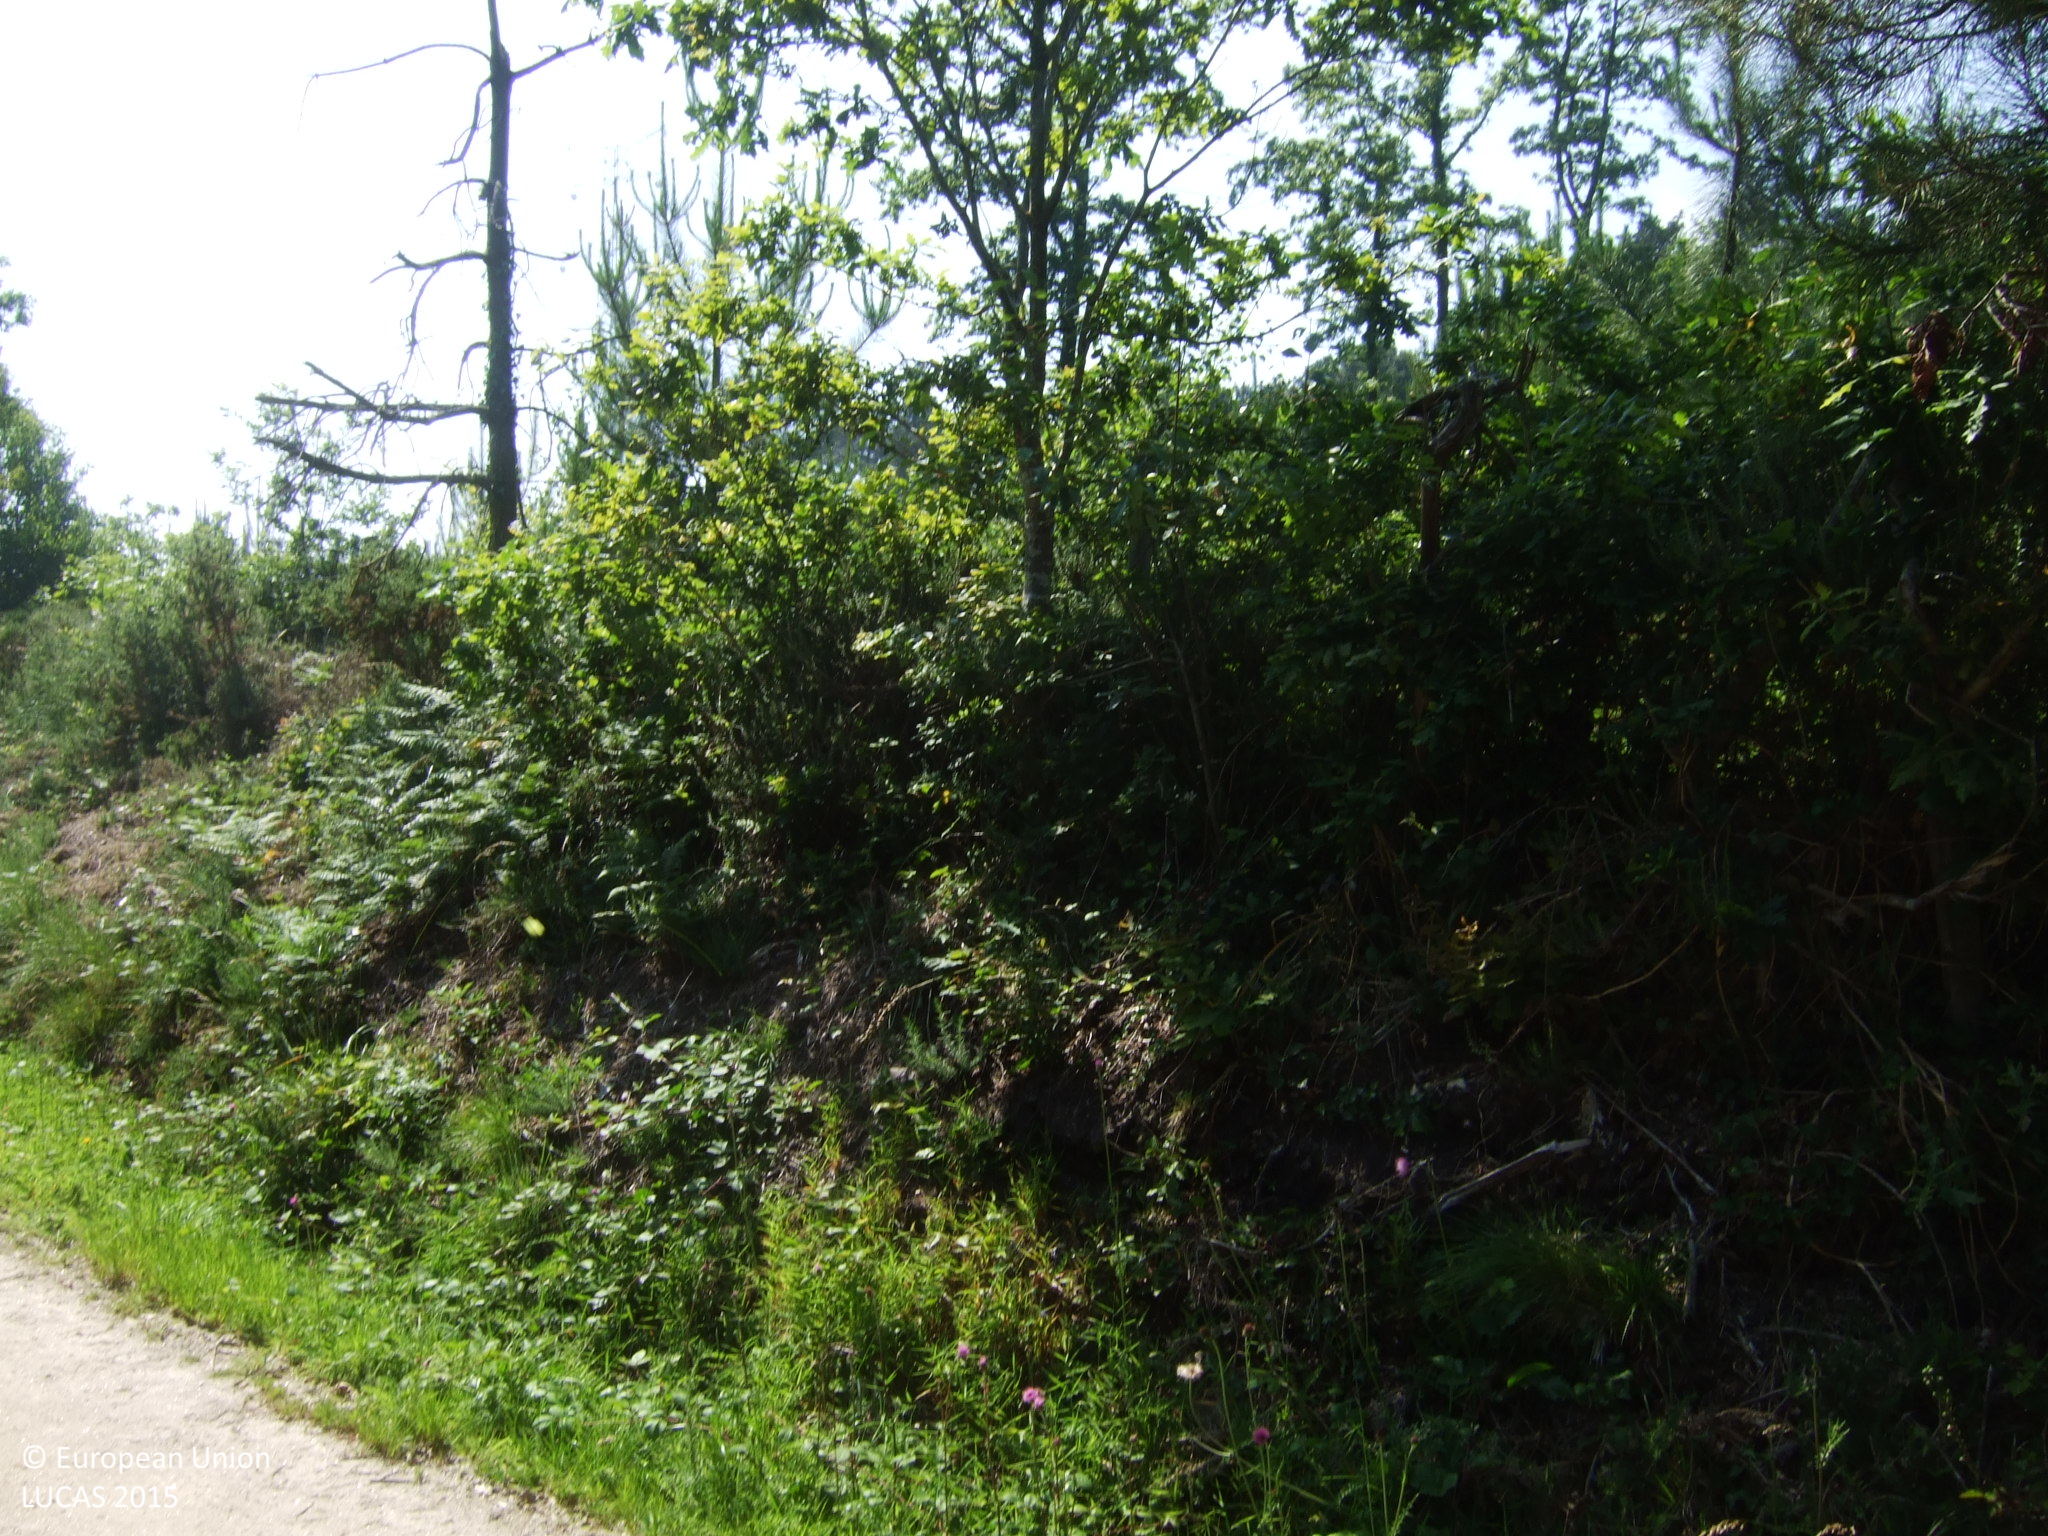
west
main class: Woodland
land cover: Broadleaved woodland
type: acidophilous oak and oak-birch forest
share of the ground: > 75 %
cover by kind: broadleaved forest trees 85 %, shrubs 15 %
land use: Forestry
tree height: > 5 m
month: June
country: ES
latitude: 43.5805
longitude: -7.5324
